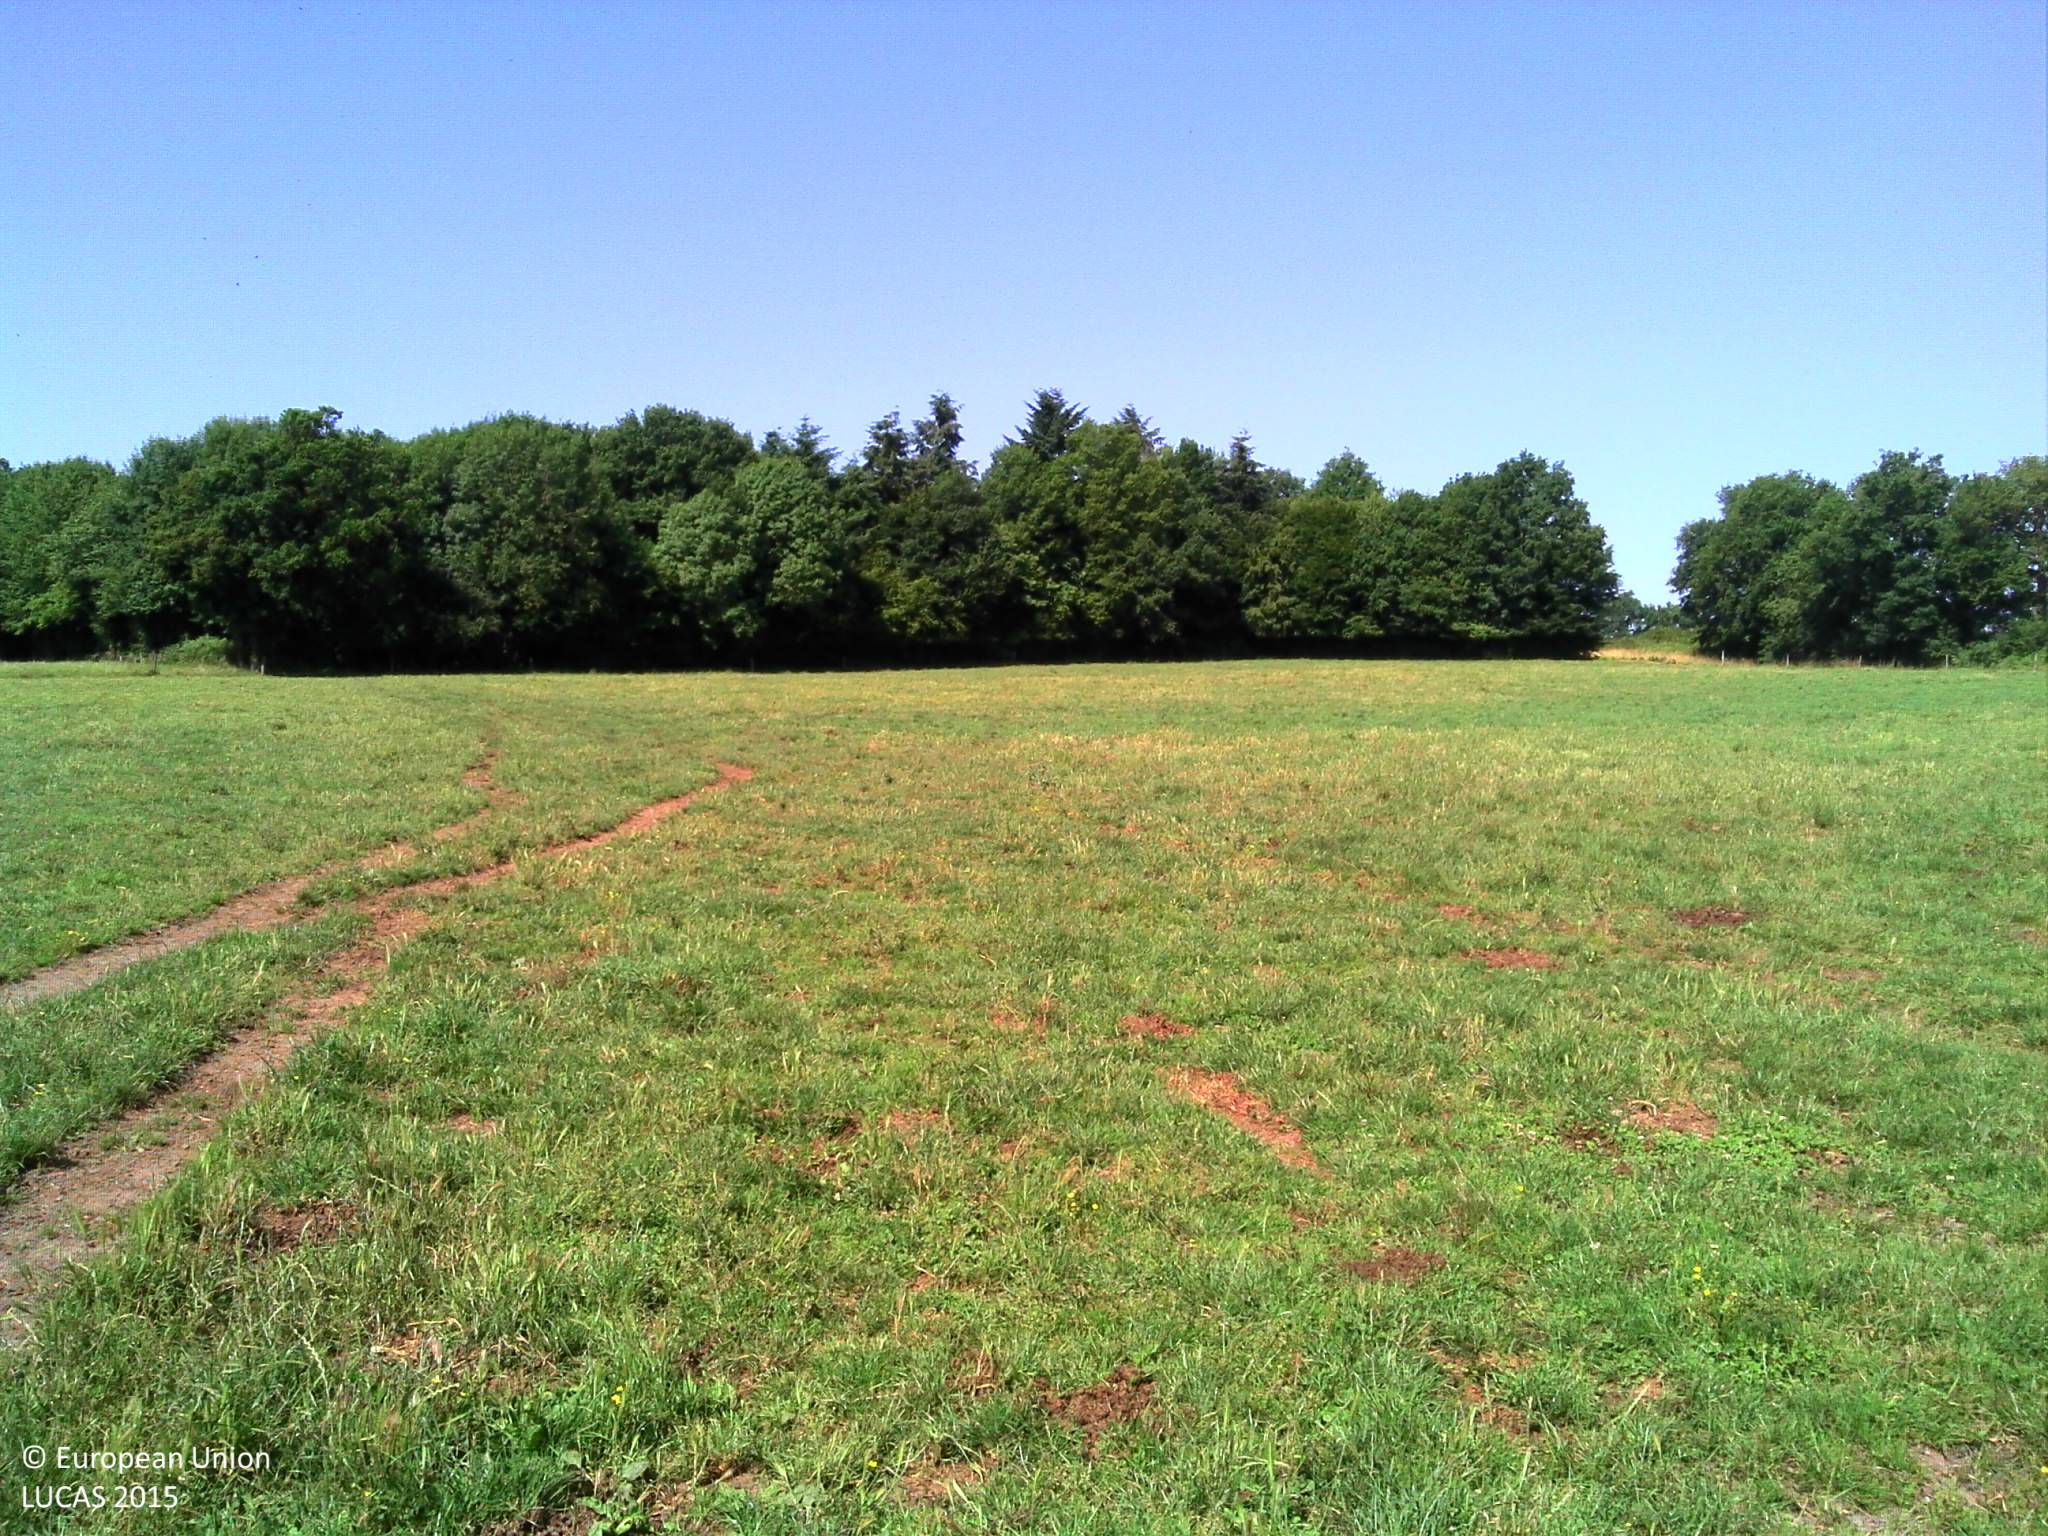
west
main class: Grassland
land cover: Grassland without tree/shrub cover
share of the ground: > 75 %
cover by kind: herbaceous plants 100 %
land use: Agriculture (excluding fallow land and kitchen gardens)
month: June
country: FR
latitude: 45.8814
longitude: 0.5928
